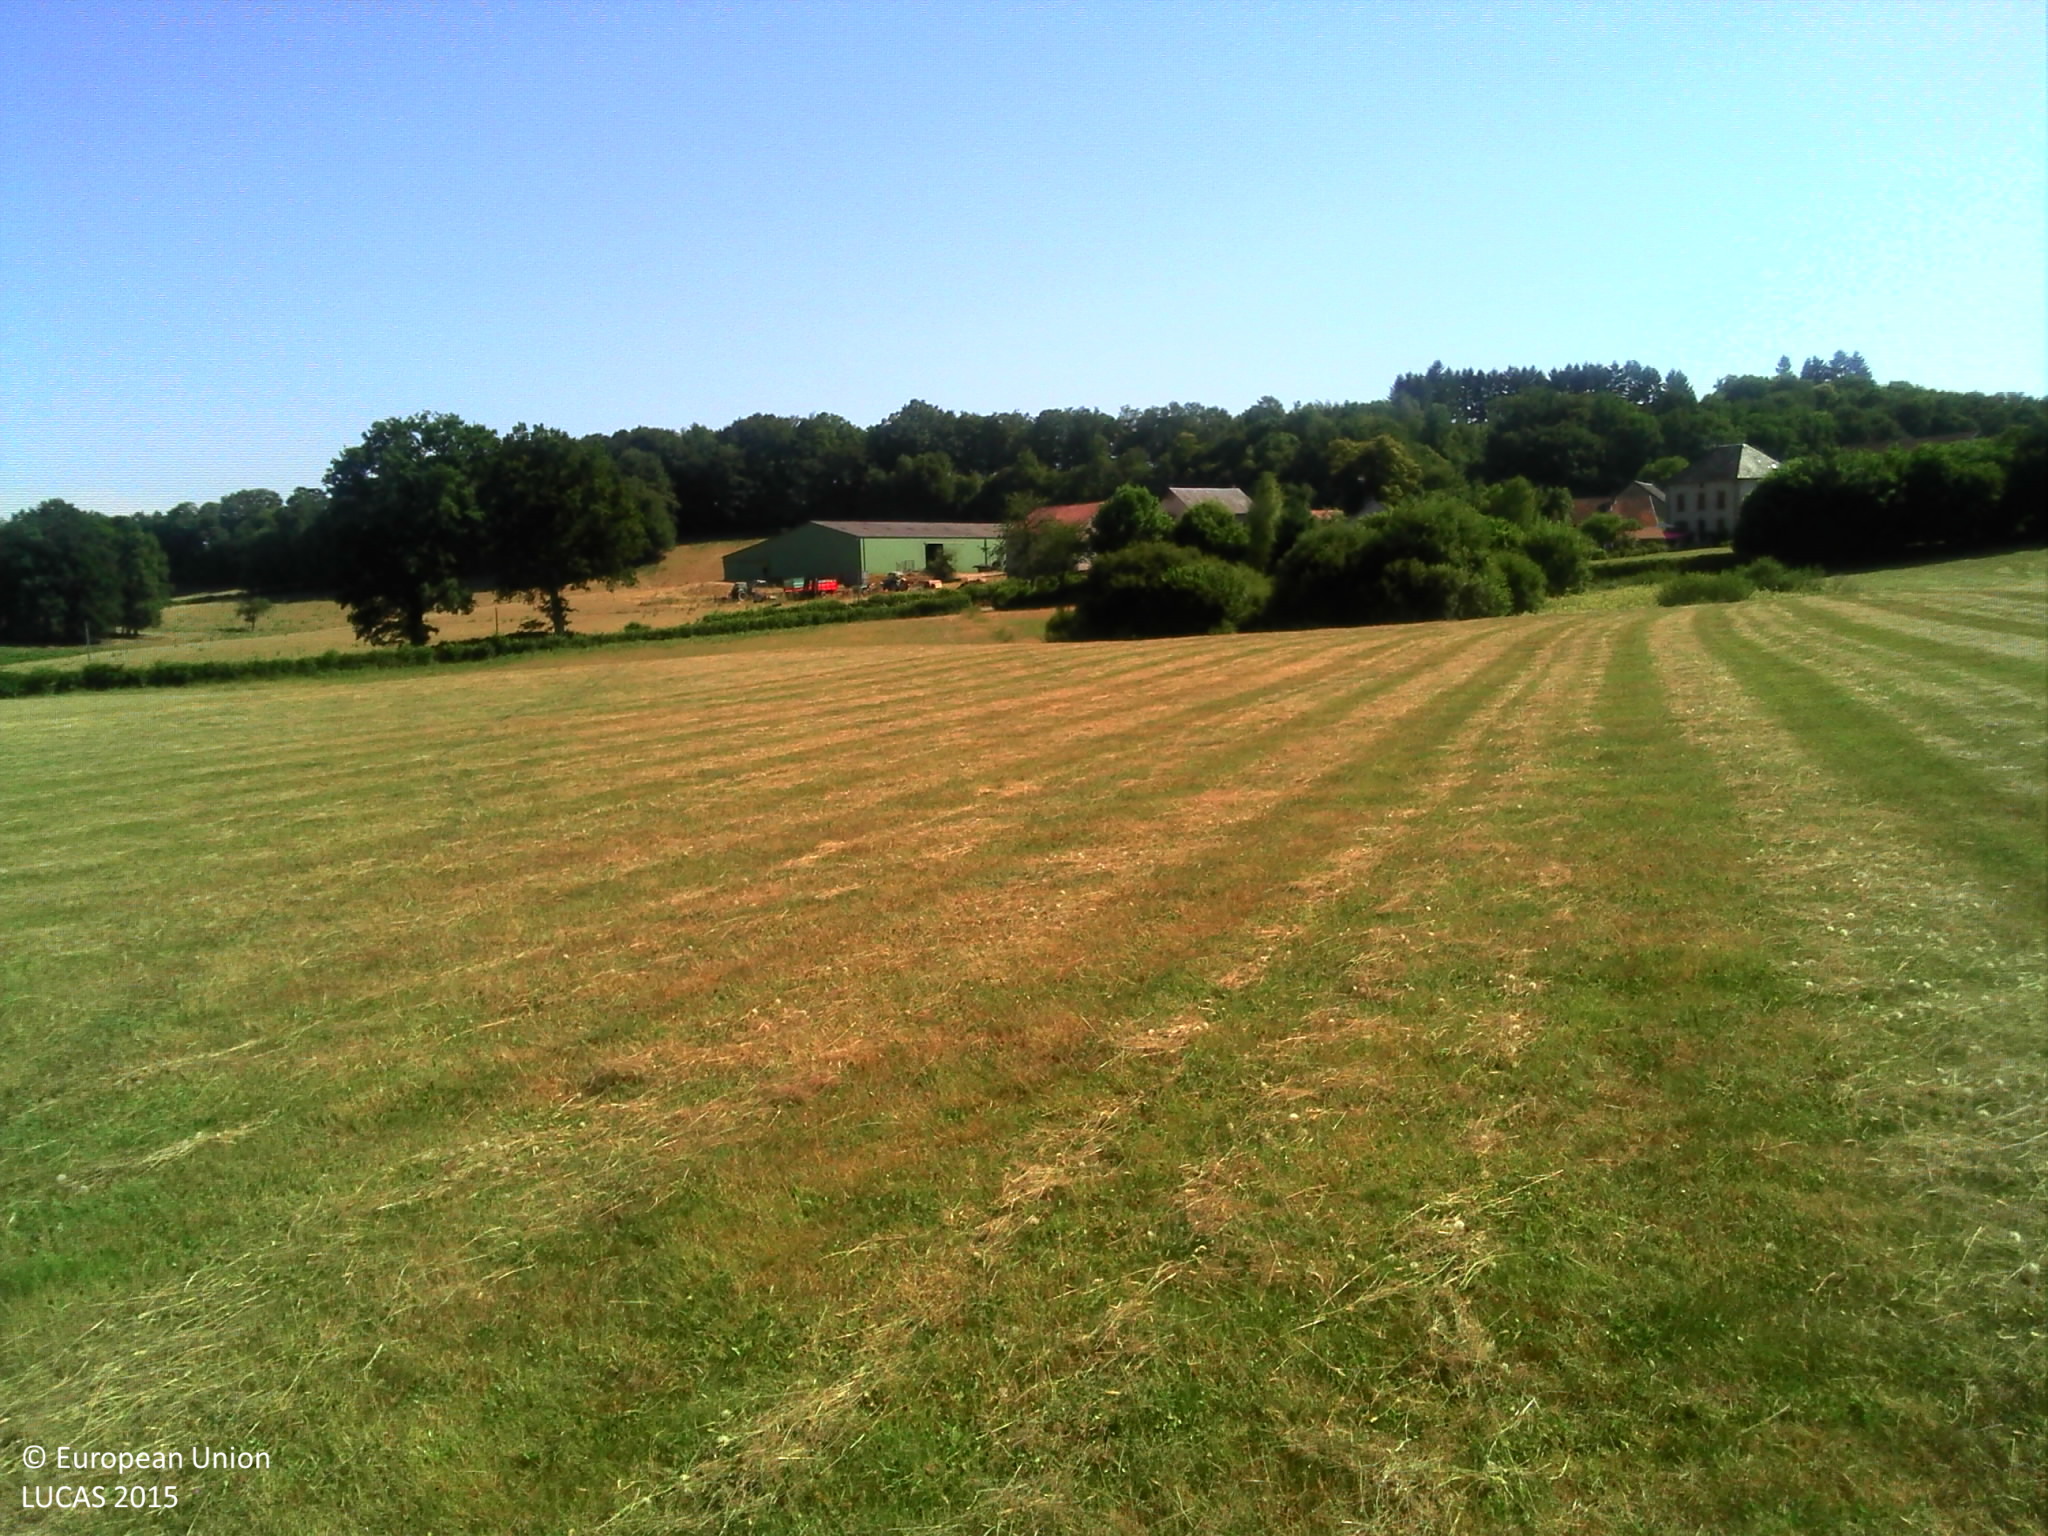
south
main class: Grassland
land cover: Grassland without tree/shrub cover
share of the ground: > 75 %
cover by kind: herbaceous plants 100 %
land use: Agriculture (excluding fallow land and kitchen gardens)
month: July
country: FR
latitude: 46.0271
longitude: 1.6858
